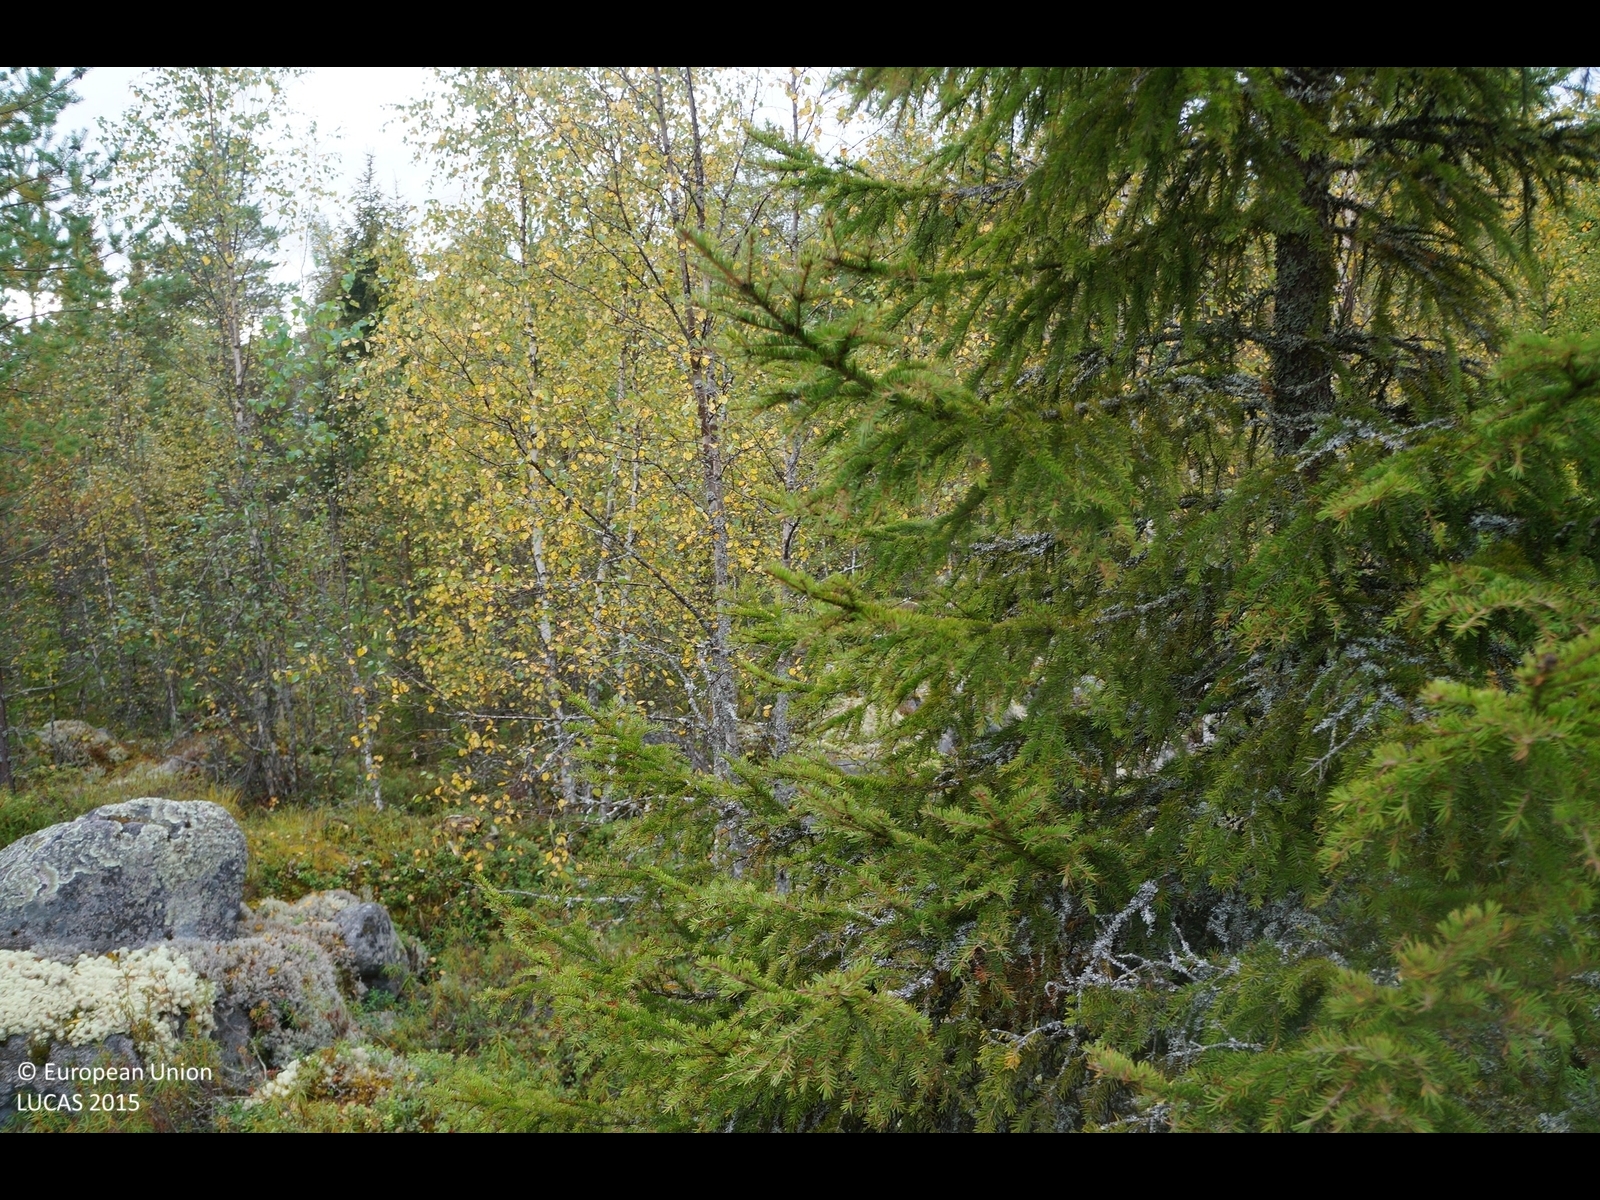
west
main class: Woodland
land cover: Other mixed woodland
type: boreal forest
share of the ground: 25 - 50 %
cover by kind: consolidated bare surface 40 %, lichens and mosses 20 %, coniferous forest trees 15 %, broadleaved forest trees 15 %, shrubs 10 %
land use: Semi-natural and natural areas not in use
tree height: < 5 m
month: September
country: FI
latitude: 64.0552
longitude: 24.1414
